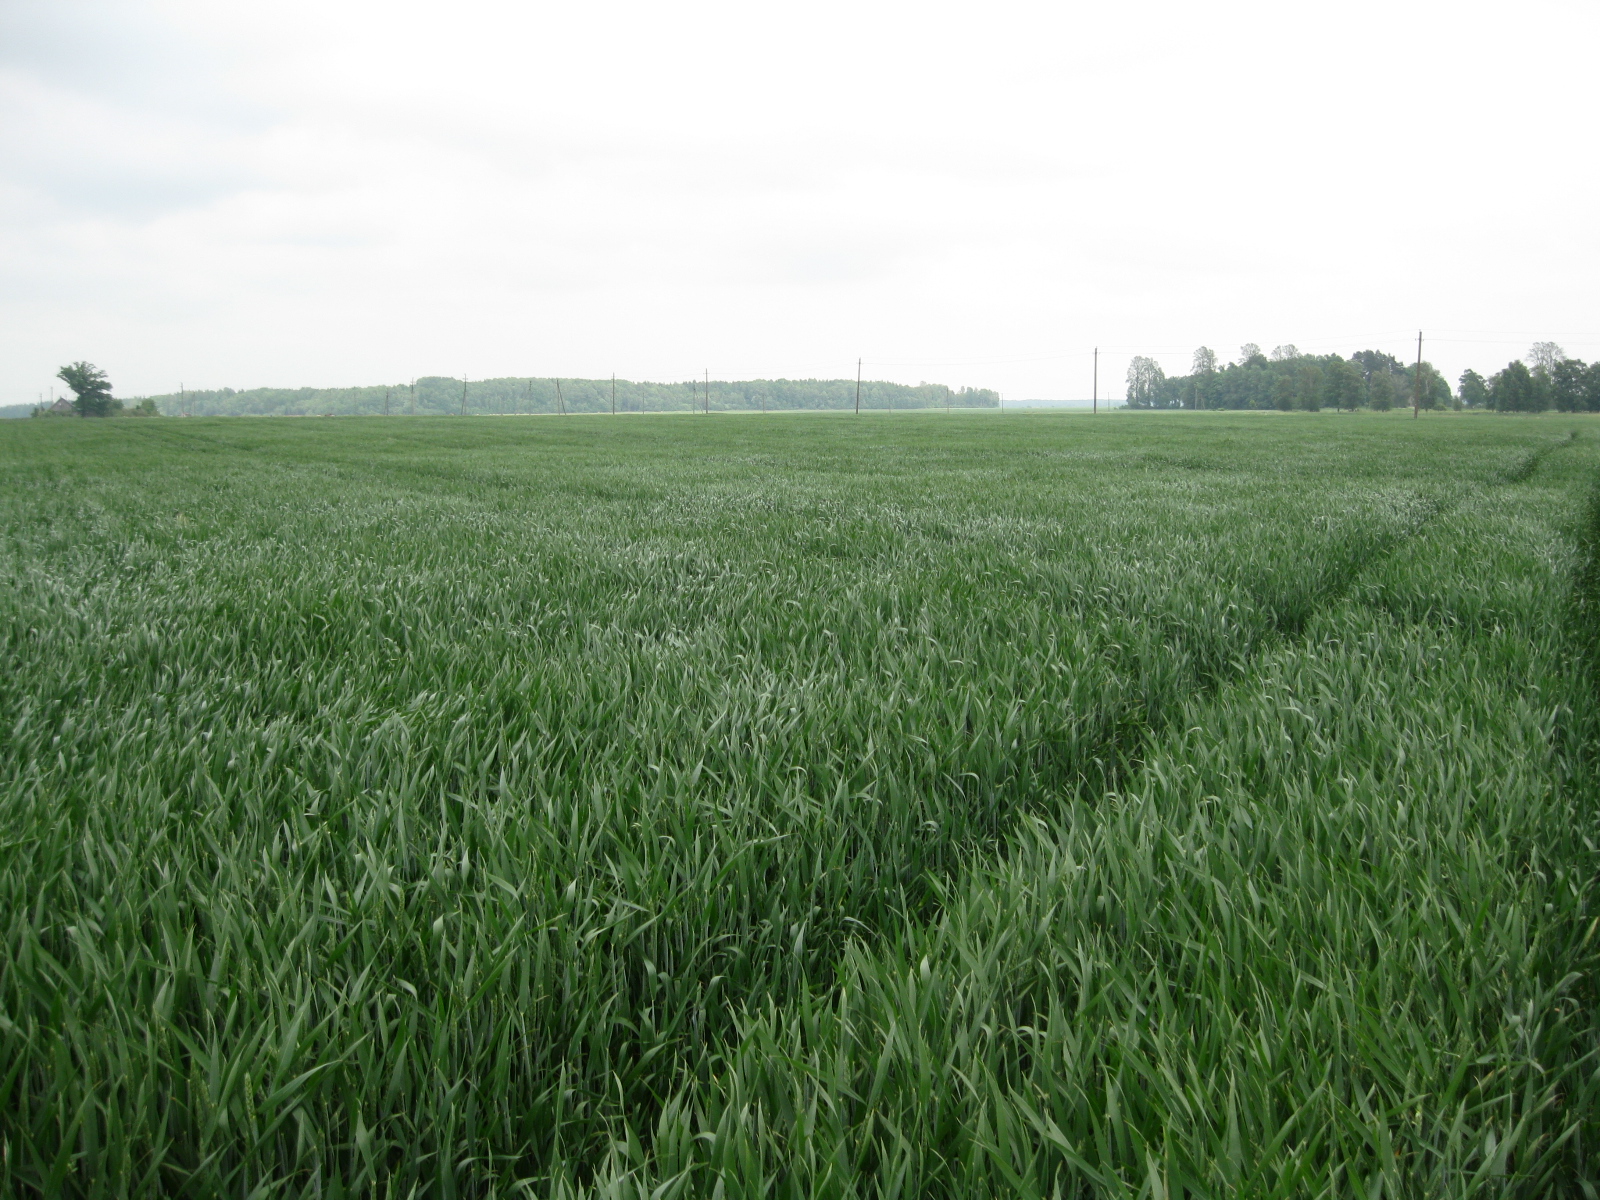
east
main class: Cropland
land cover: Common wheat
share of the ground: > 75 %
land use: Agriculture (excluding fallow land and kitchen gardens)
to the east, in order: Common wheat; Electric lines; Common wheat
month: June
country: LT
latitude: 55.2862
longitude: 23.5108
